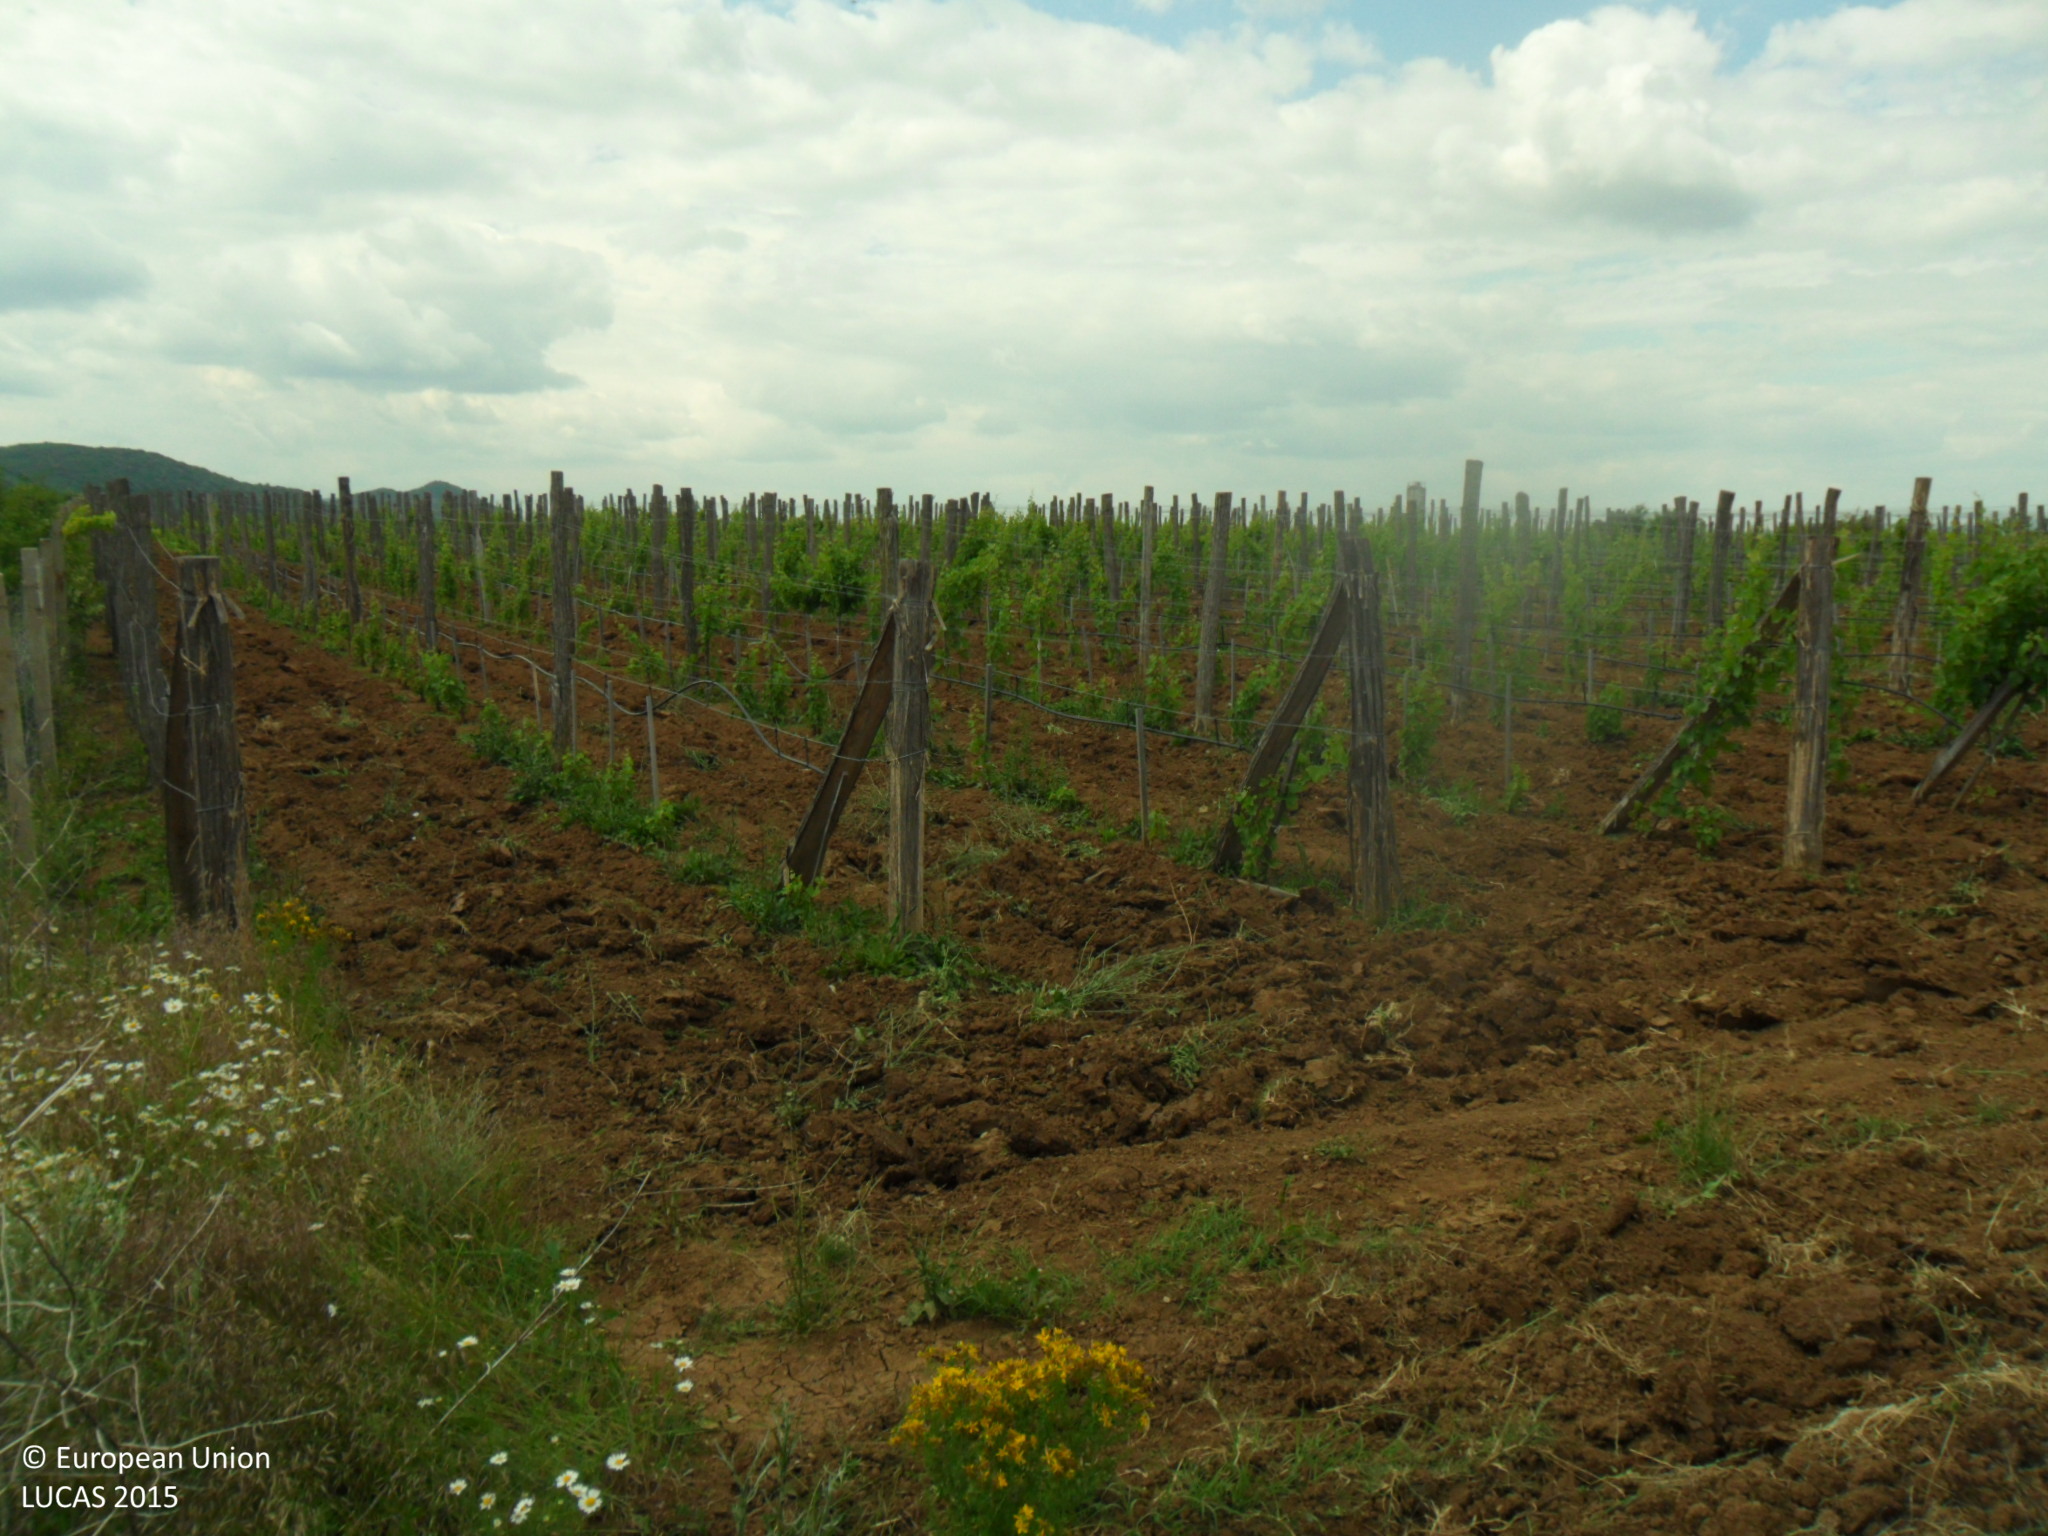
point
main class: Cropland
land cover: Vineyards
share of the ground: 10 - 25 %
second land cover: Other bare soil
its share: > 75 %
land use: Agriculture (excluding fallow land and kitchen gardens)
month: June
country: BG
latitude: 43.1024
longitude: 26.8814
